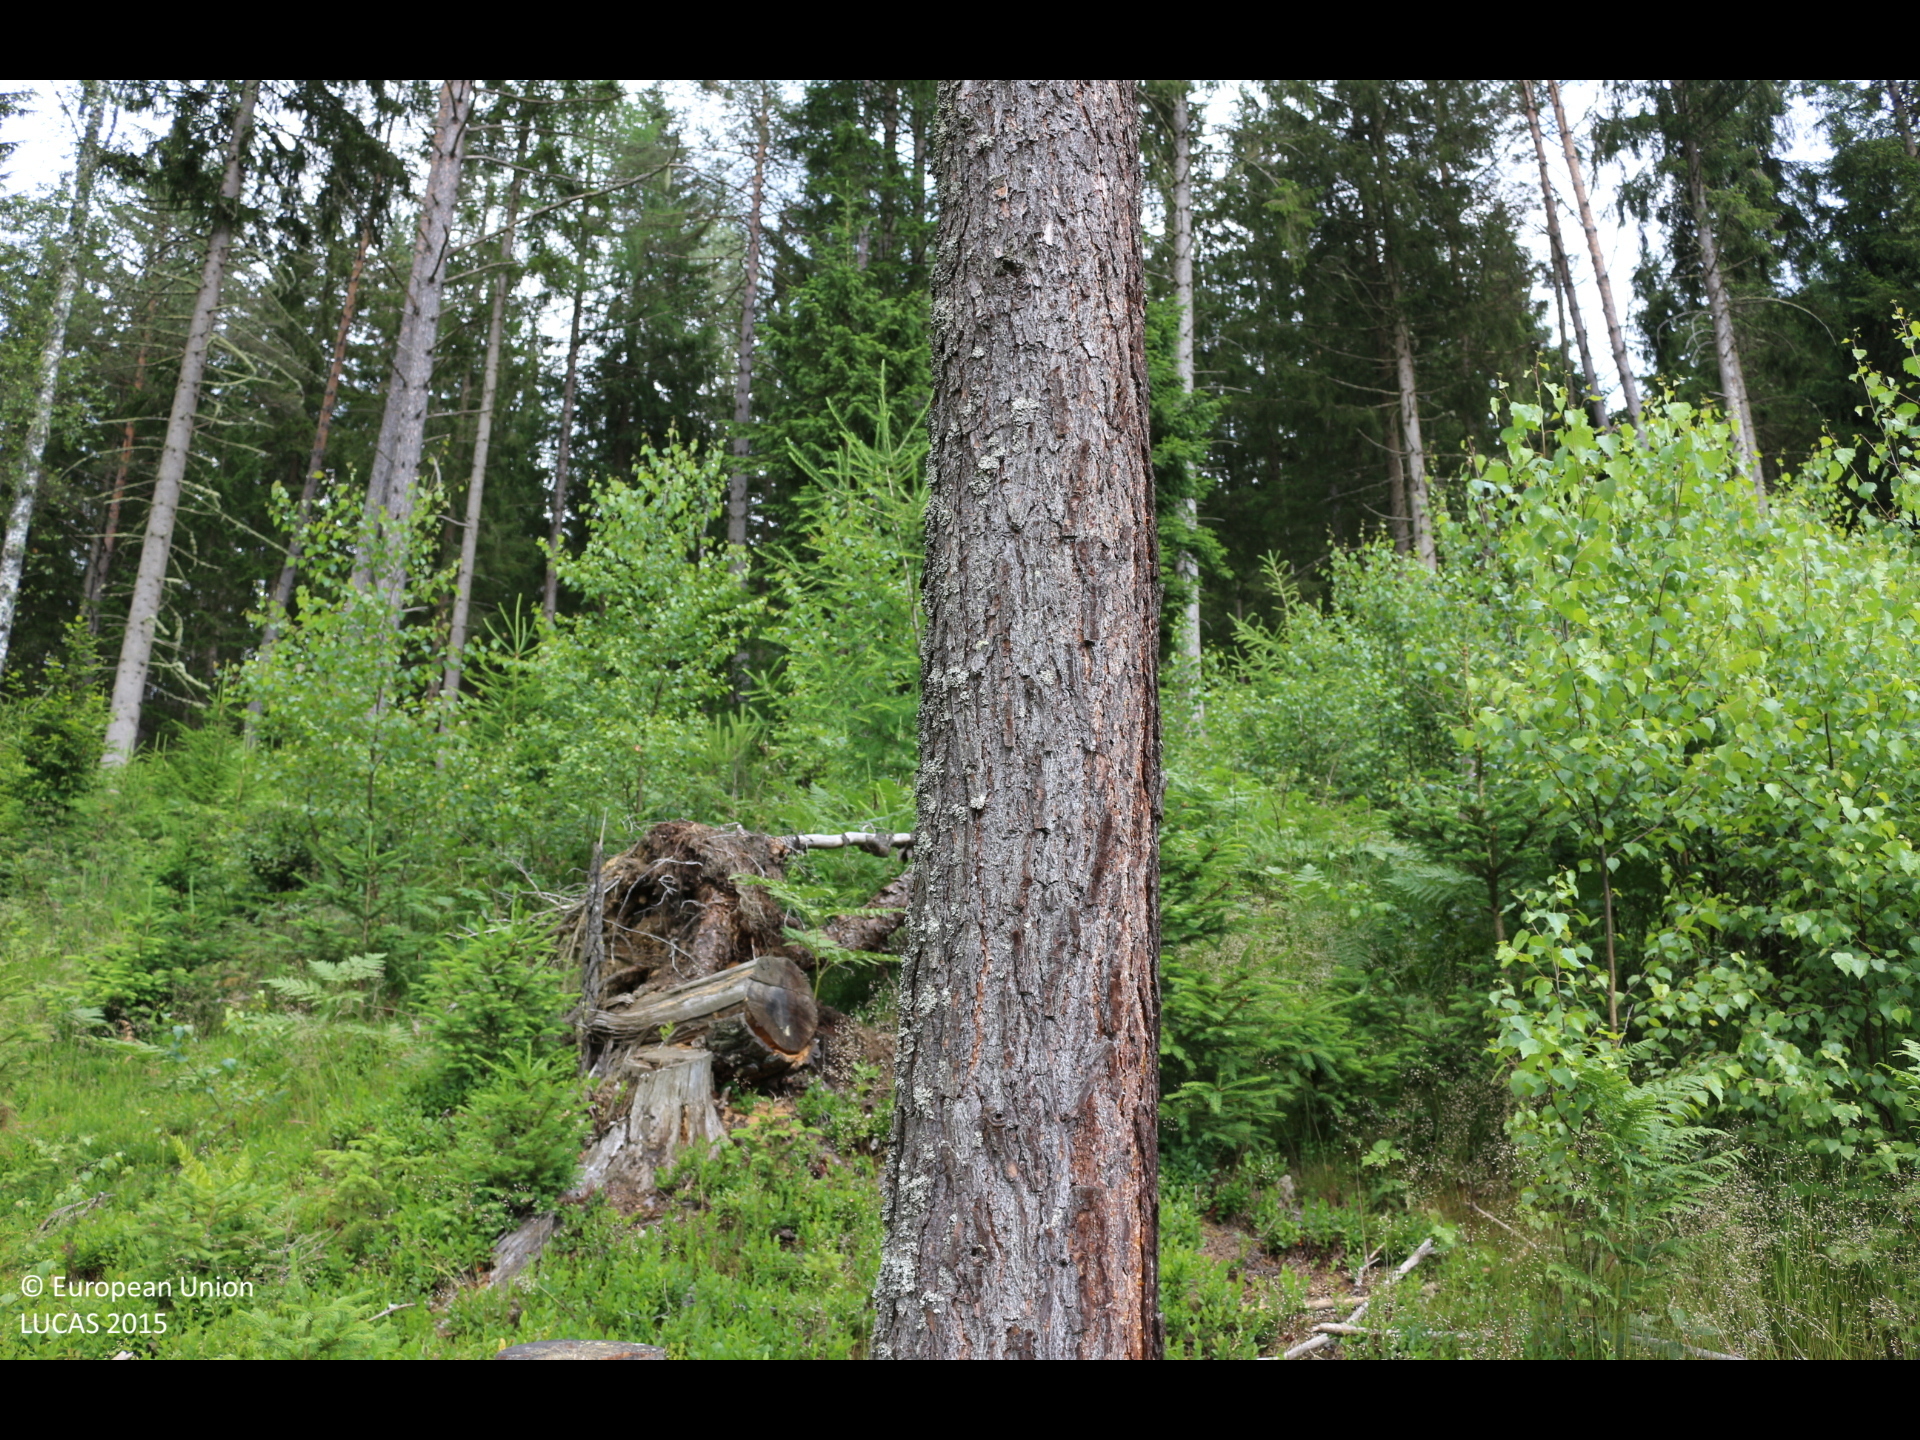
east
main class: Shrubland
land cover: Shrubland with sparse tree cover
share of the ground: > 75 %
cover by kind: shrubs 75 %, herbaceous plants 20 %, coniferous forest trees 5 %
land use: Forestry
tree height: > 5 m
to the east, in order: Shrubland with sparse tree cover; Other coniferous woodland; Tracks; Spruce dominated coniferous woodland; Tracks; Spruce dominated coniferous woodland; Tracks; Spruce dominated coniferous woodland
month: June
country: AT
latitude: 46.8835
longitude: 14.1577
